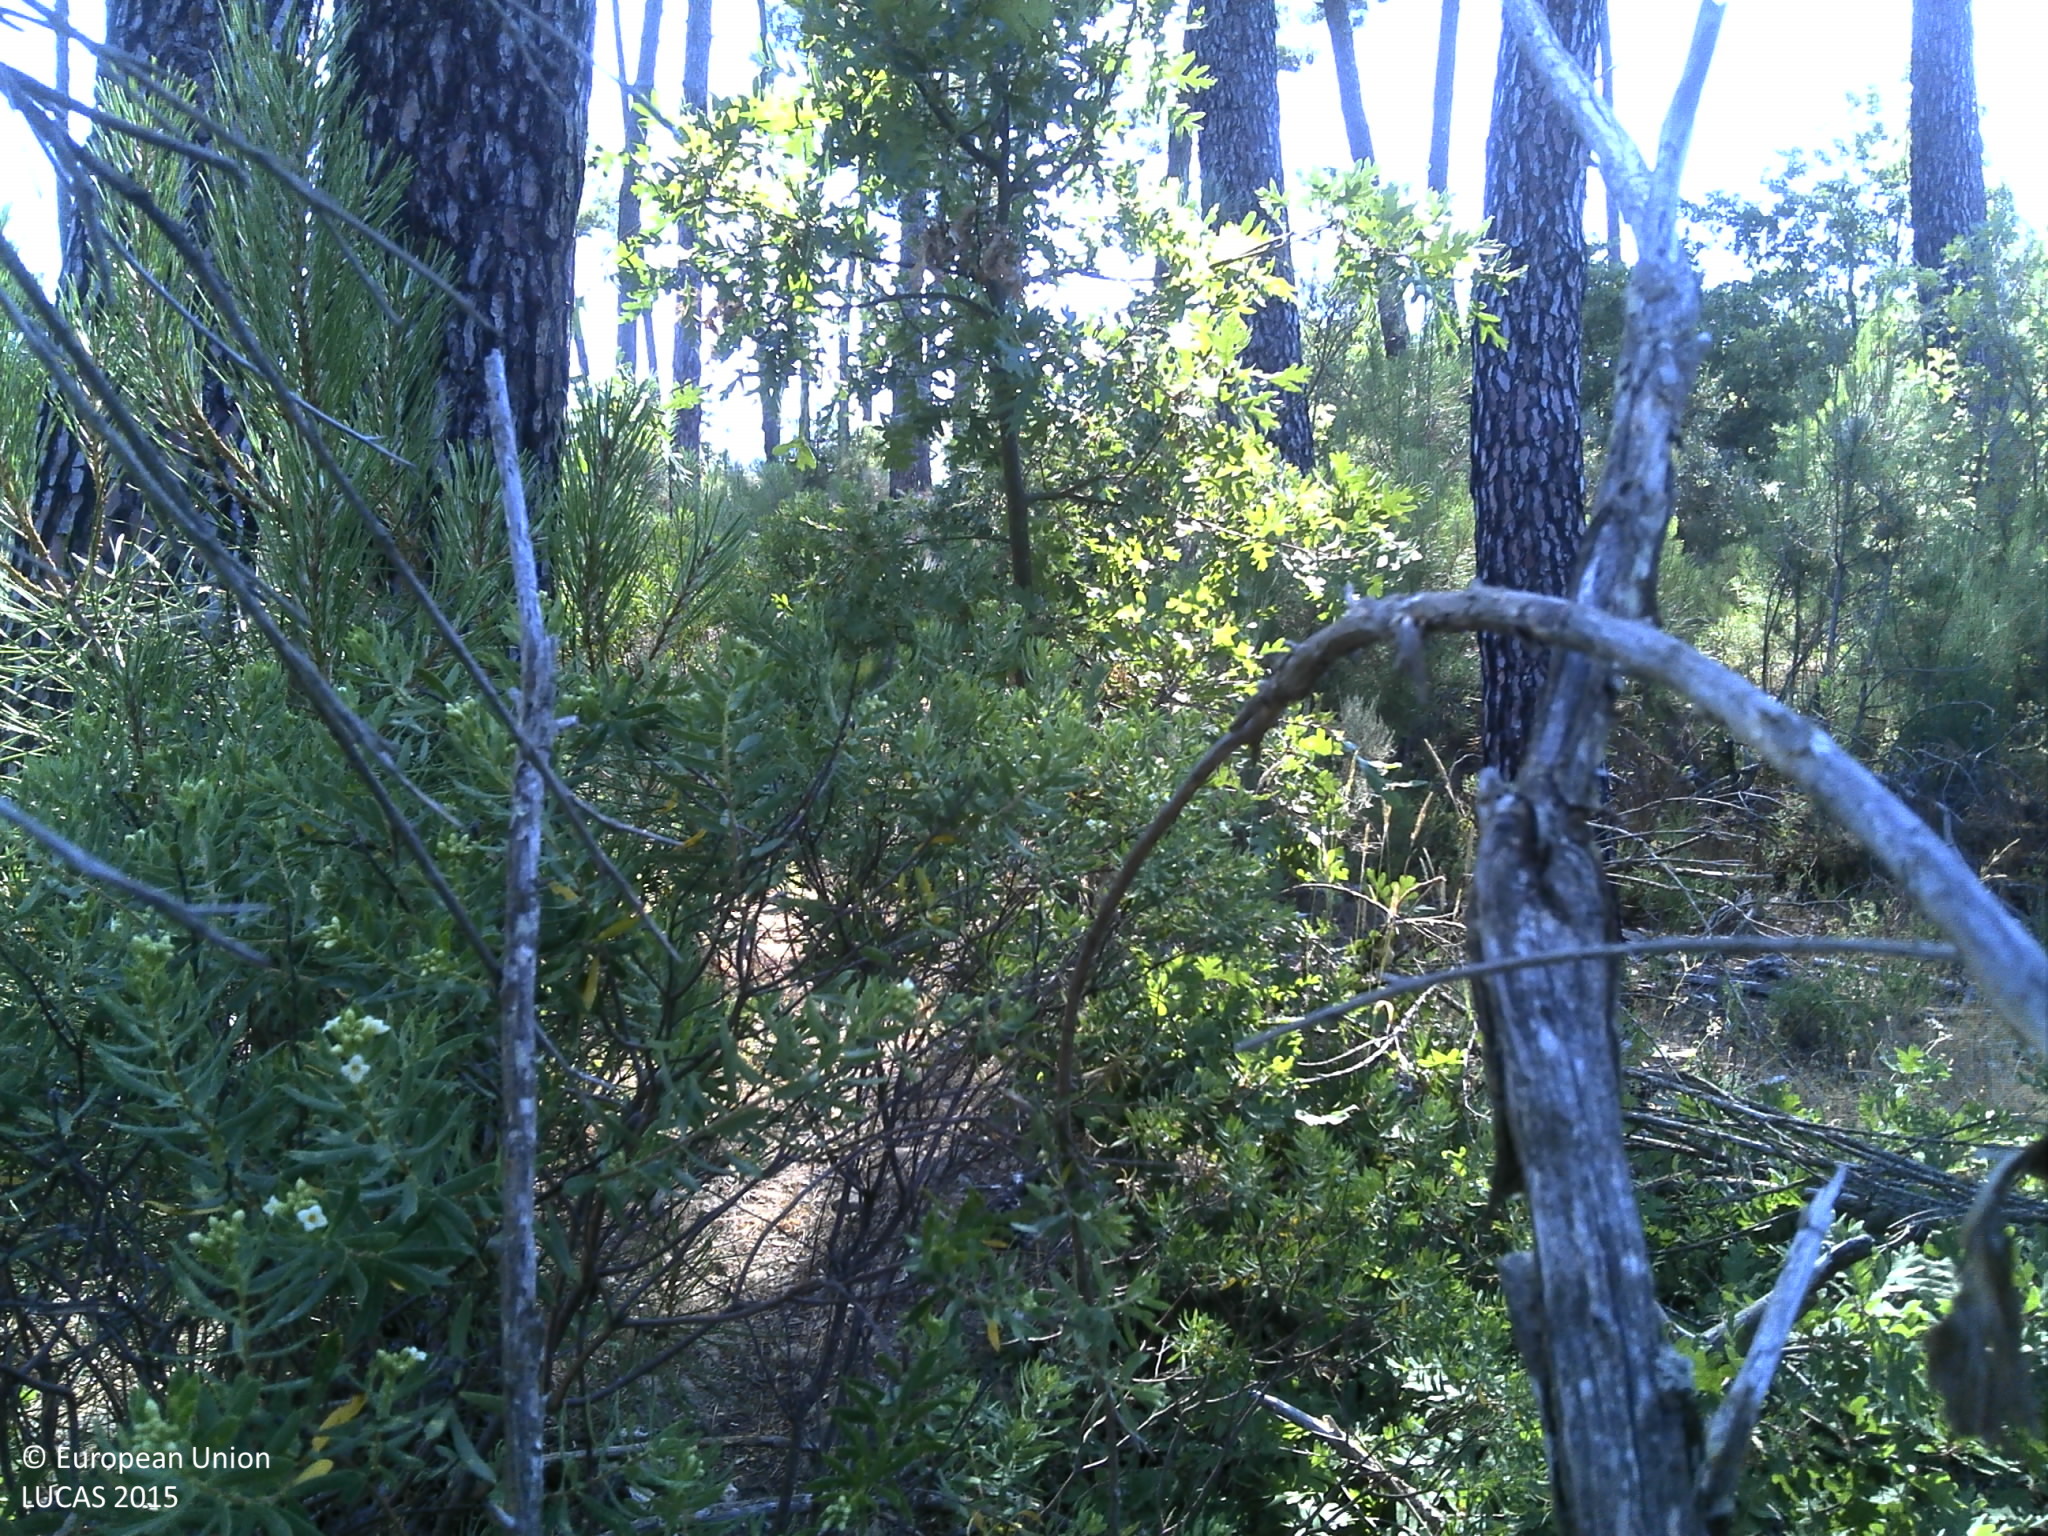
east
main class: Woodland
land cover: Pine dominated mixed woodland
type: coniferous forest of the mediterranean region
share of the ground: 50 - 75 %
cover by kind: shrubs 50 %, coniferous forest trees 30 %, broadleaved forest trees 10 %, unconsolidated bare surface 10 %
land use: Forestry
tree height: > 5 m
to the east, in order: Pine dominated mixed woodland; Shrubland without tree cover; Pine dominated coniferous woodland; Shrubland with sparse tree cover
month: June
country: PT
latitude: 40.7597
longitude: -7.2253
